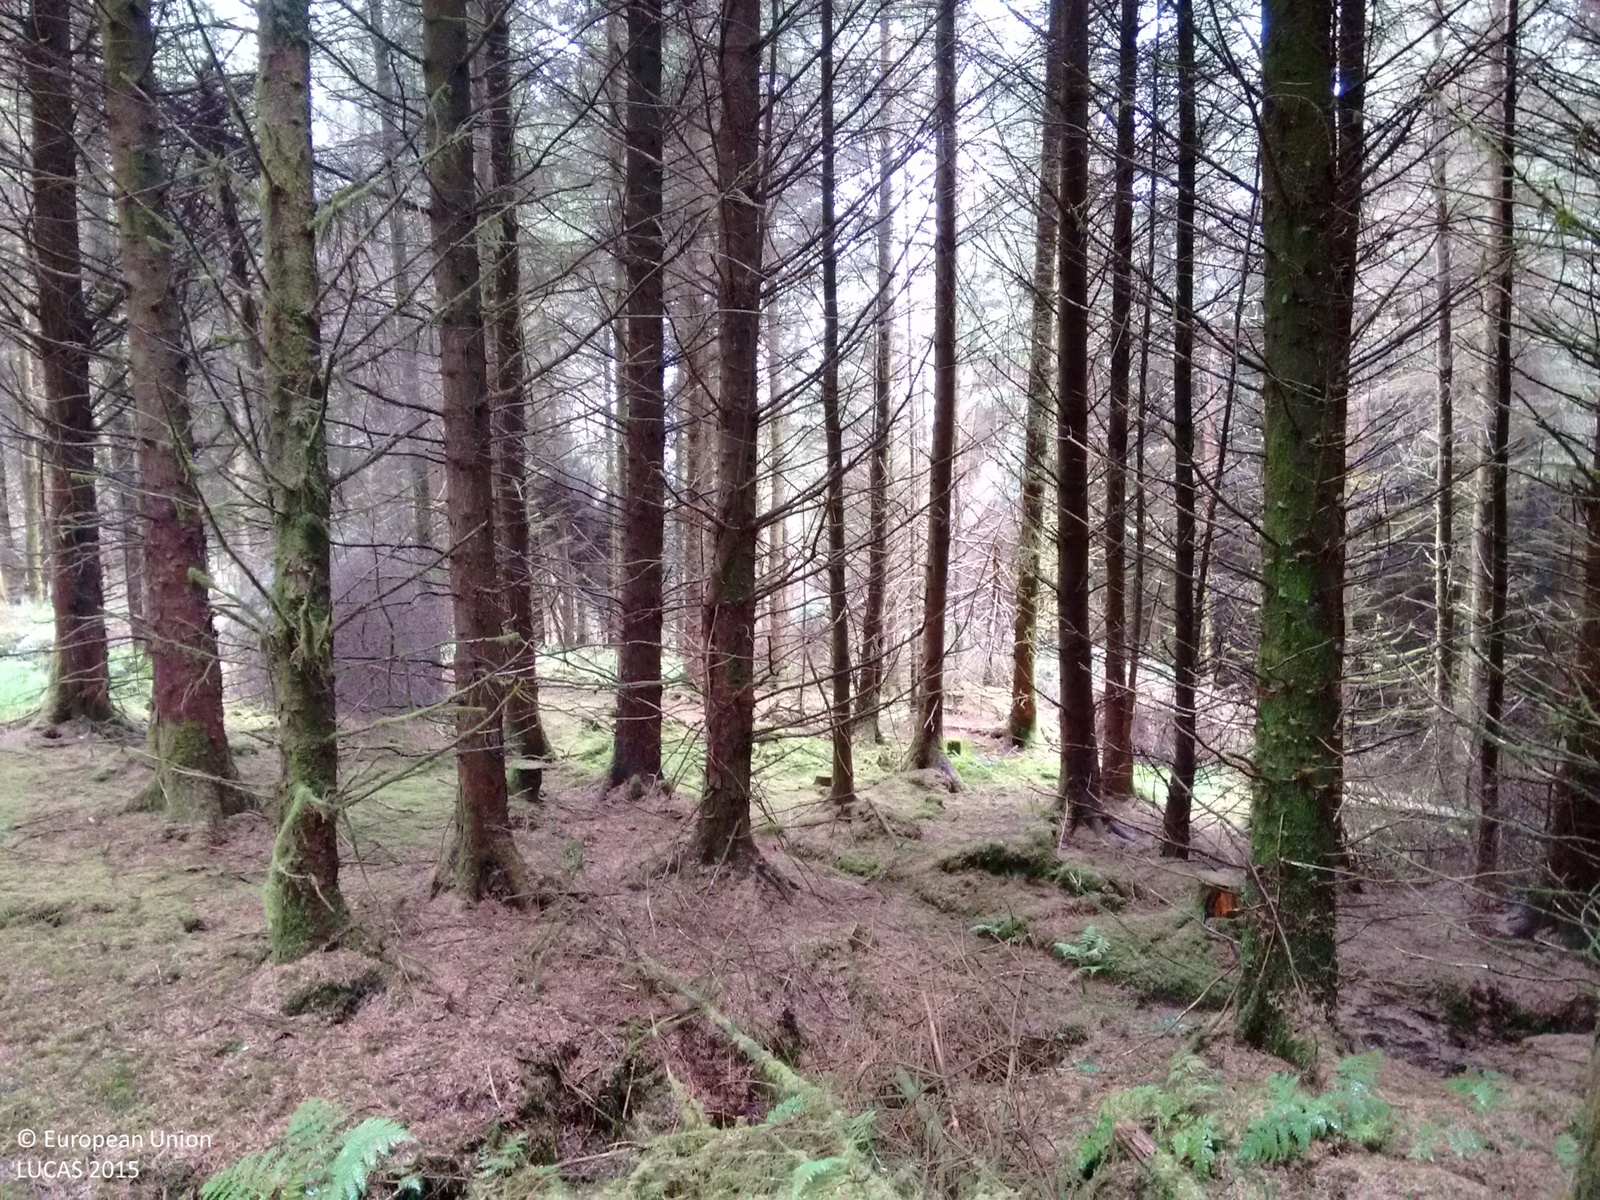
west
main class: Woodland
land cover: Spruce dominated mixed woodland
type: exotic forest
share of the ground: > 75 %
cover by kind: coniferous forest trees 75 %, broadleaved forest trees 25 %
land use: Forestry
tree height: > 5 m
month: July
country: IE
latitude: 52.6849
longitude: -8.3391
